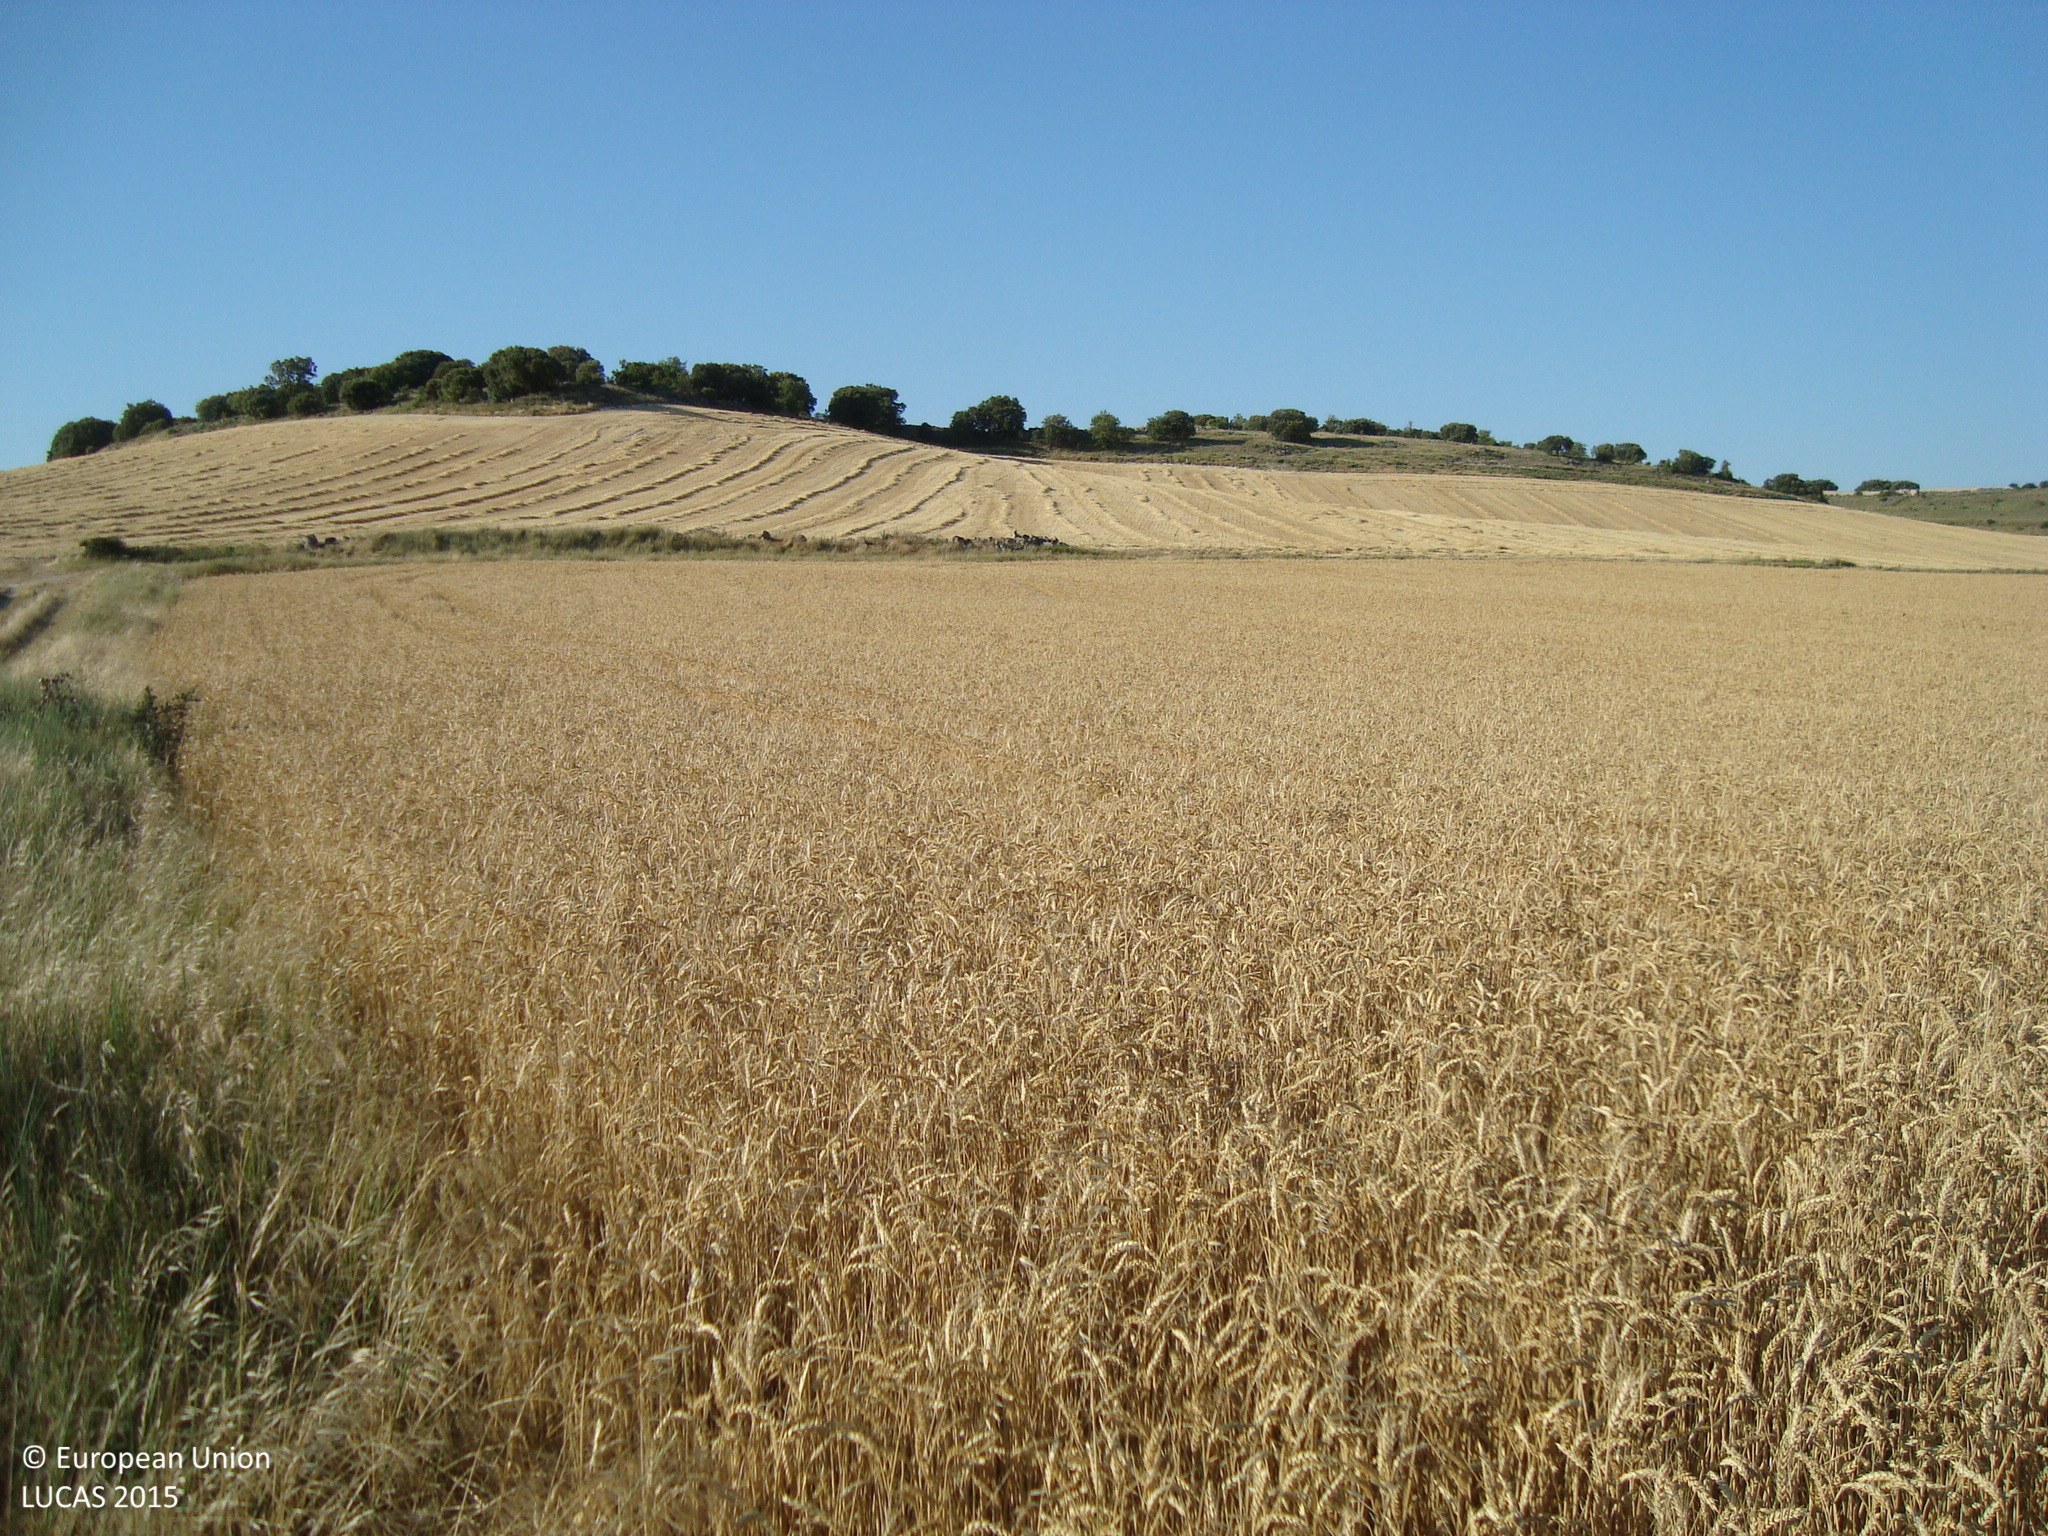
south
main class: Cropland
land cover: Common wheat
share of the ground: > 75 %
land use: Agriculture (excluding fallow land and kitchen gardens)
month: July
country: ES
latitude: 41.8580
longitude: -4.2662
